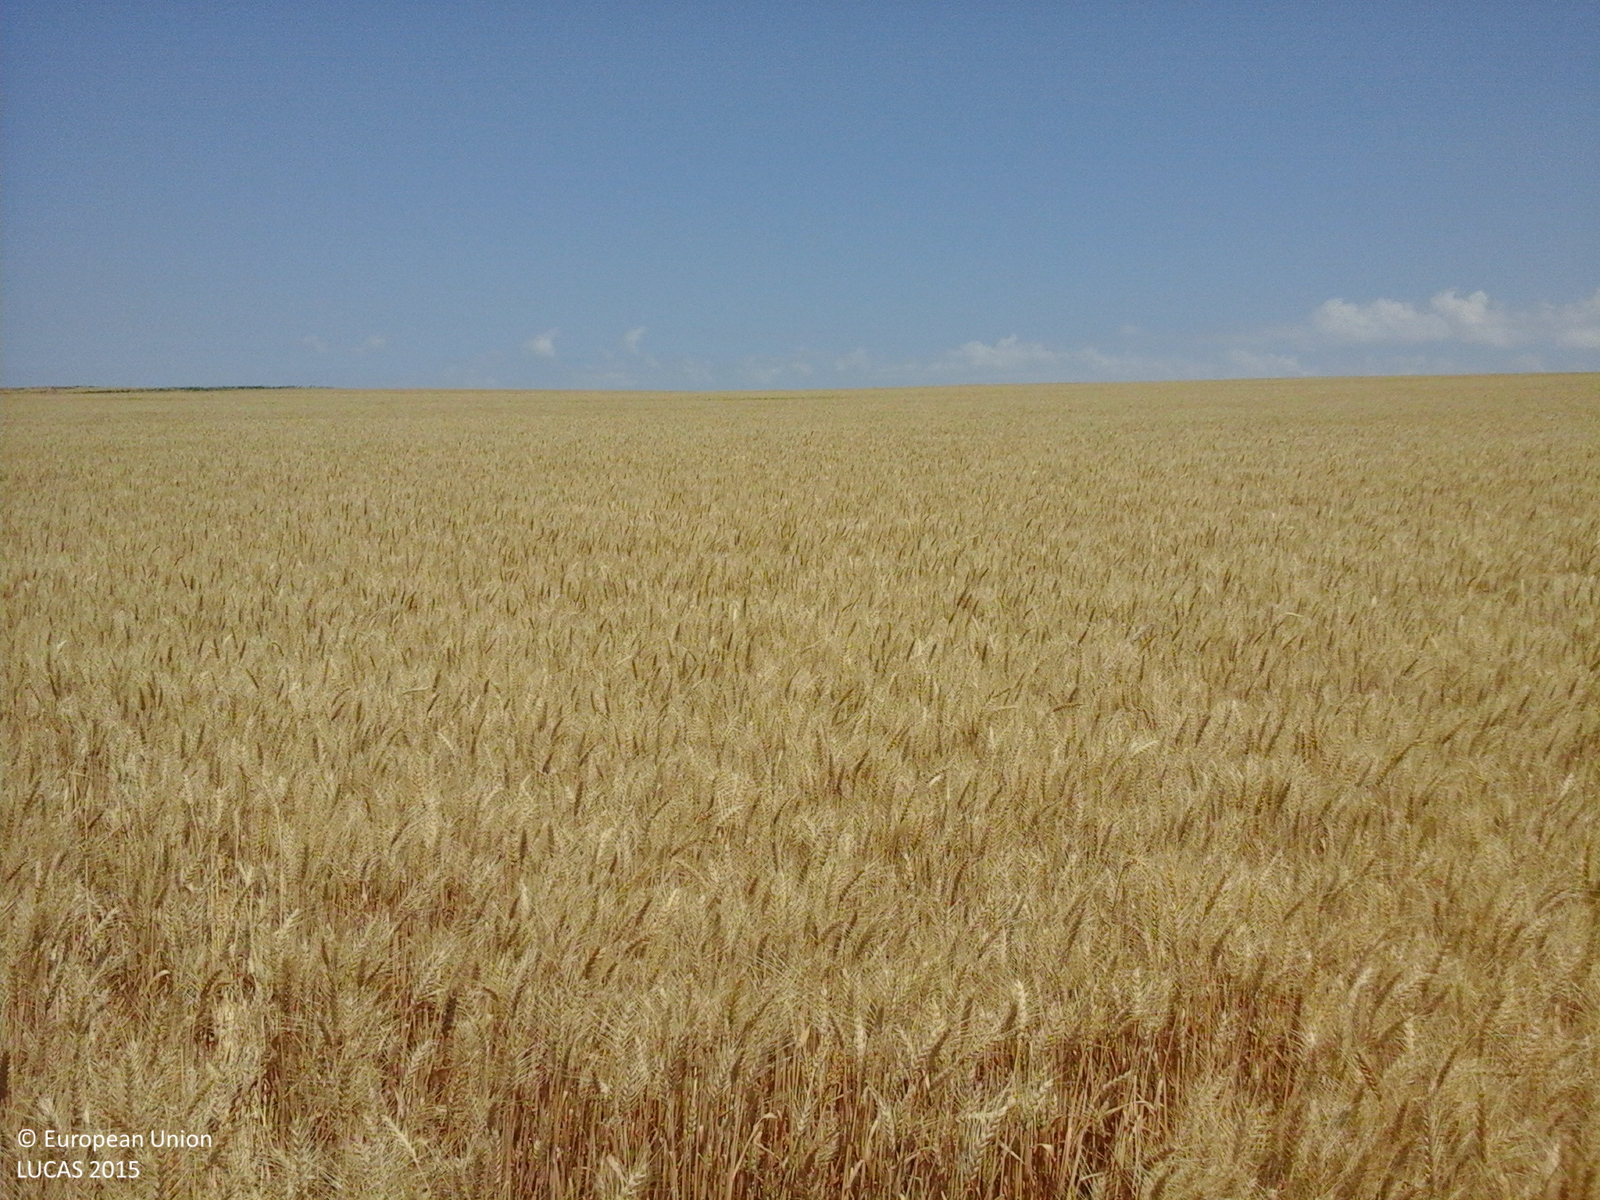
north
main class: Cropland
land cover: Common wheat
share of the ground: > 75 %
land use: Agriculture (excluding fallow land and kitchen gardens)
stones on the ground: < 10 %
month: June
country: RO
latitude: 46.6748
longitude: 27.8623
